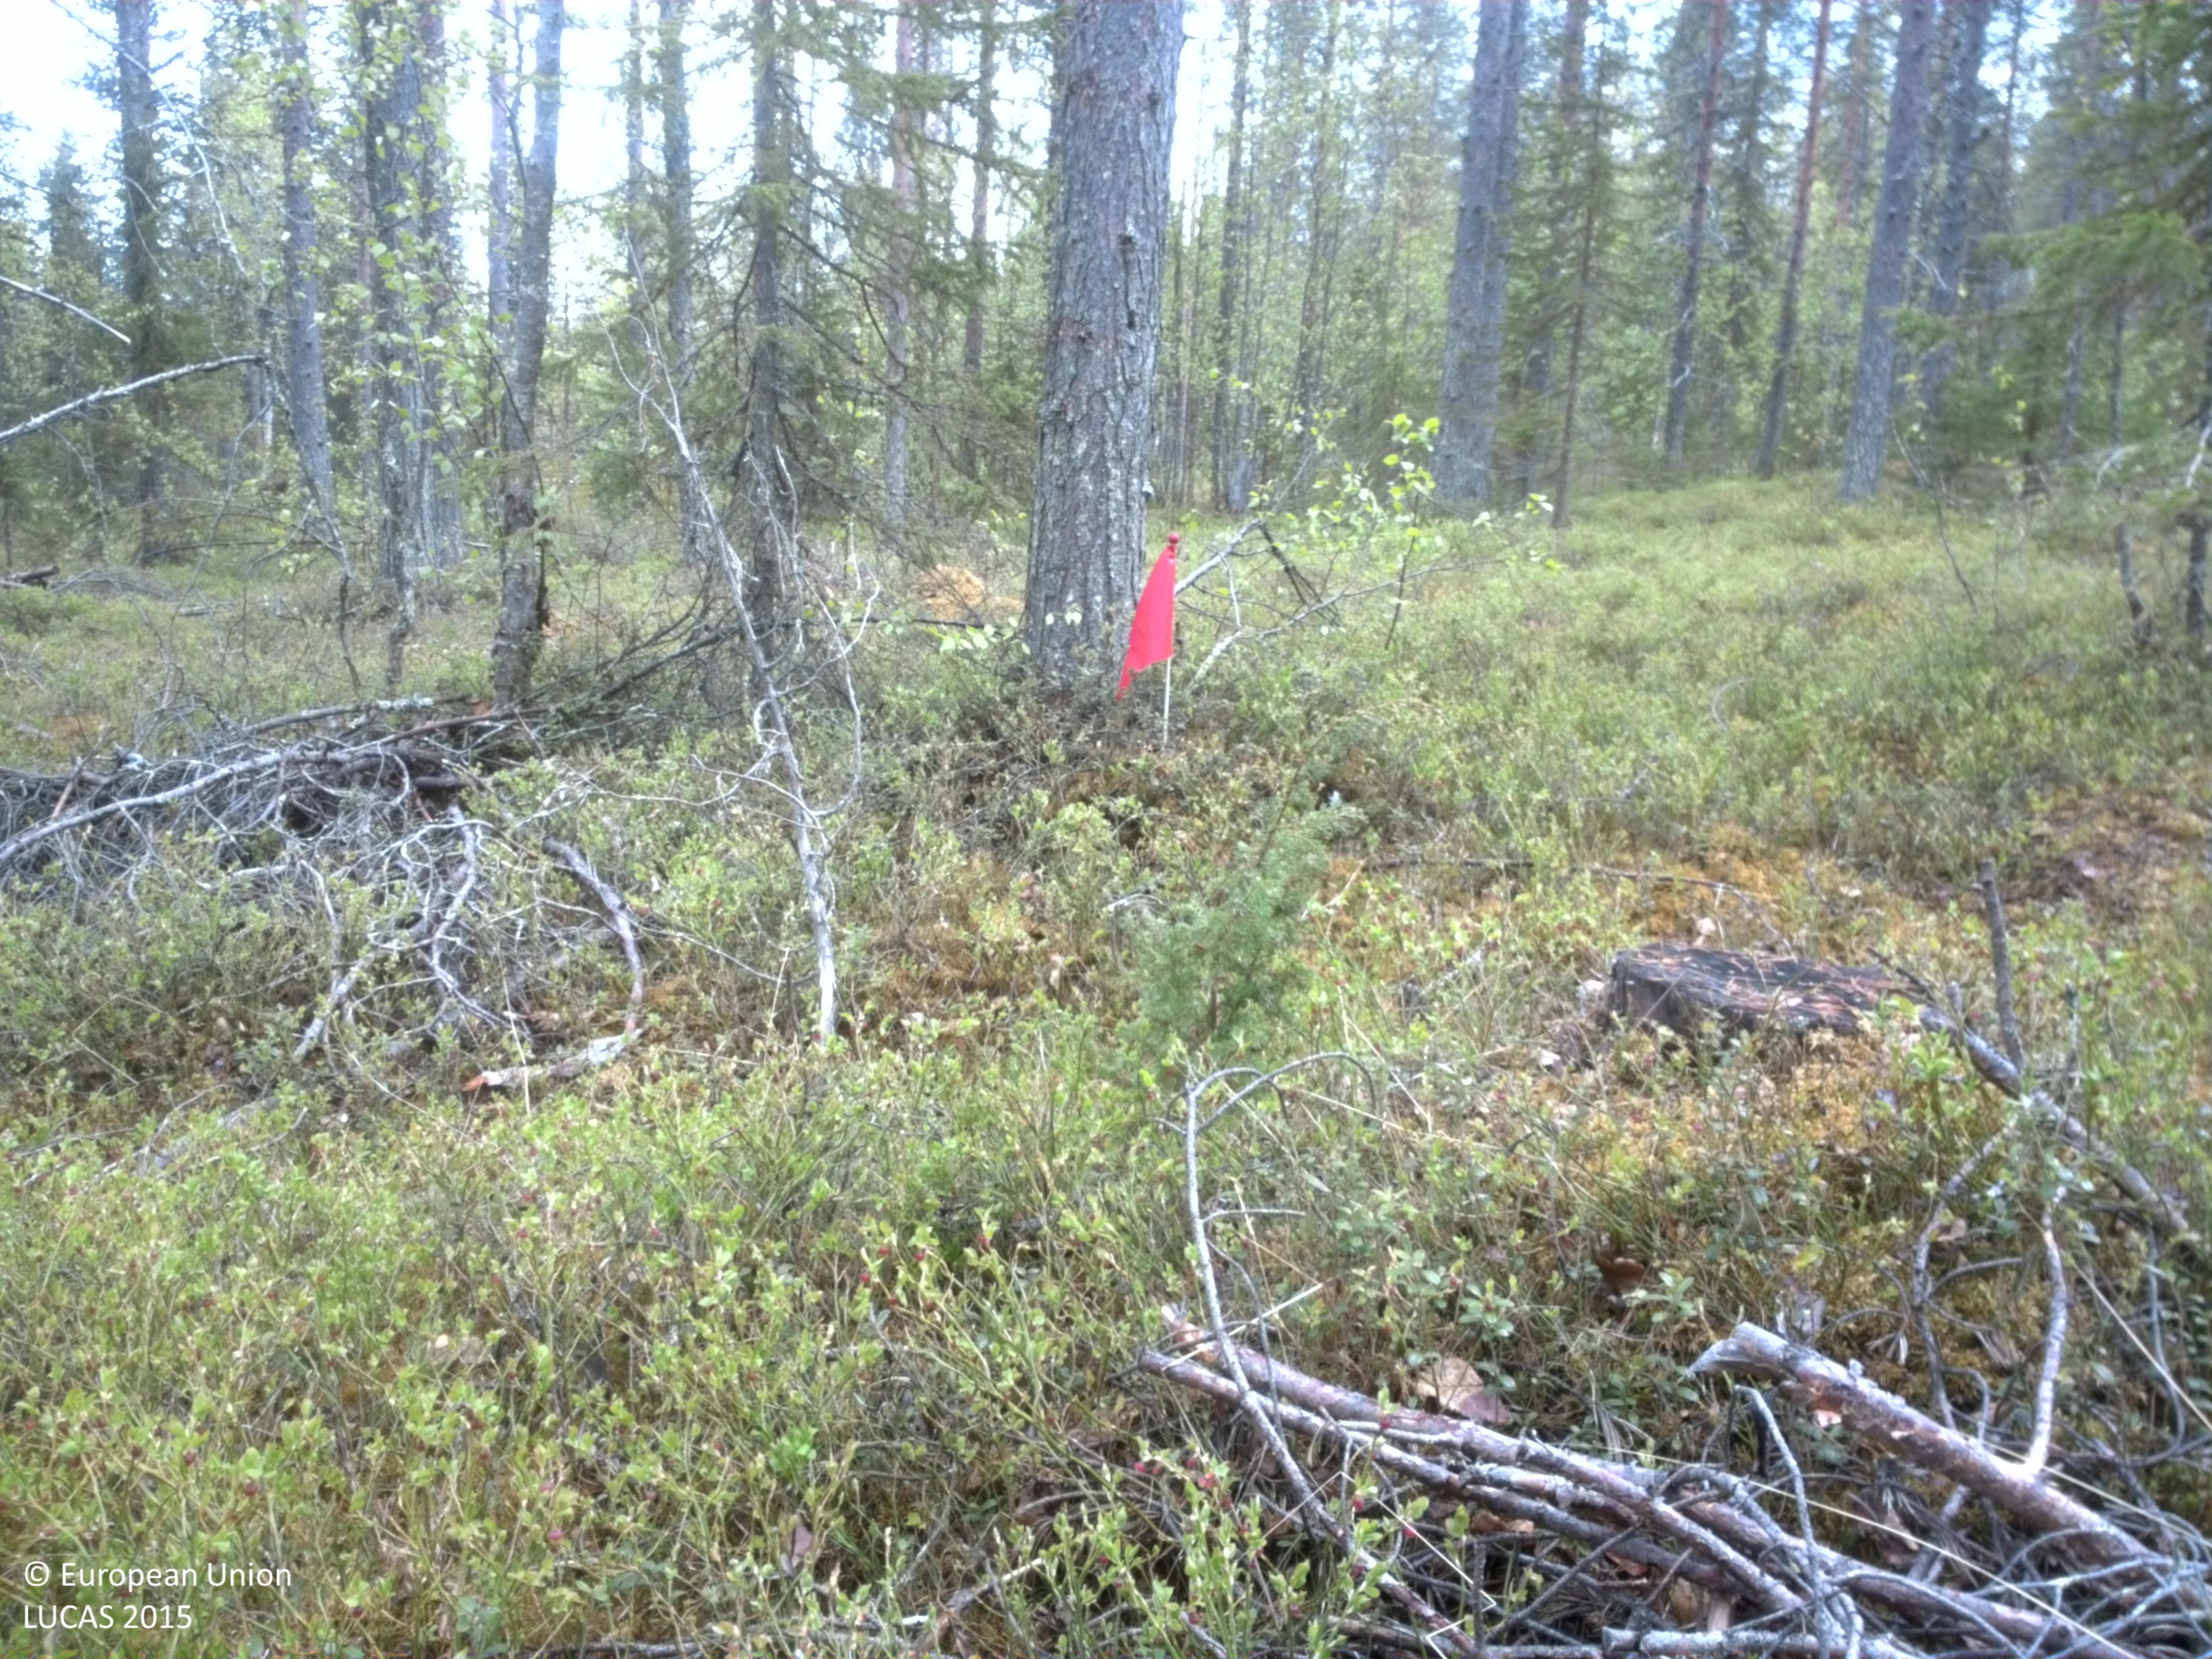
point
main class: Woodland
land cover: Pine dominated coniferous woodland
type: boreal forest
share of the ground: 10 - 25 %
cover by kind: herbaceous plants 65 %, coniferous forest trees 20 %, broadleaved forest trees 5 %, shrubs 5 %, lichens and mosses 5 %
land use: Forestry
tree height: > 5 m
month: June
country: SE
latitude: 66.7522
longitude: 22.4320
